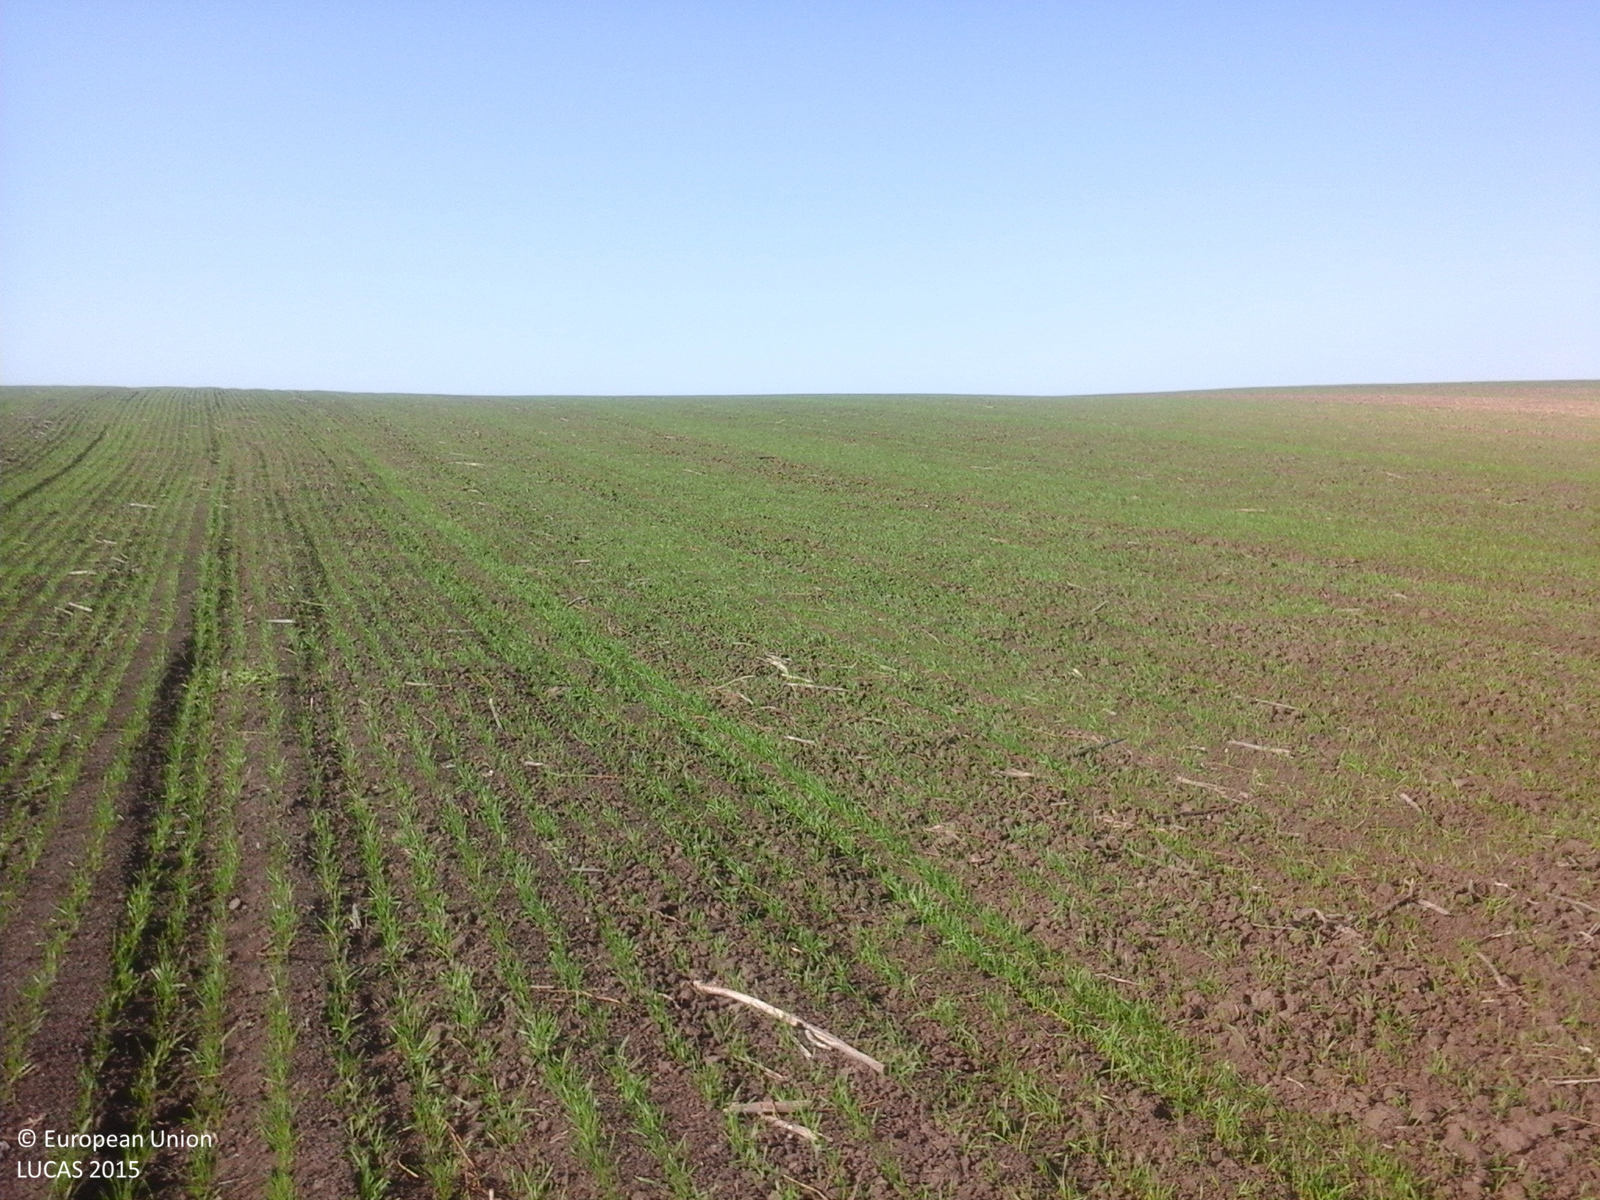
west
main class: Cropland
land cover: Common wheat
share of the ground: 50 - 75 %
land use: Agriculture (excluding fallow land and kitchen gardens)
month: October
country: RO
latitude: 45.2477
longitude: 26.8092
